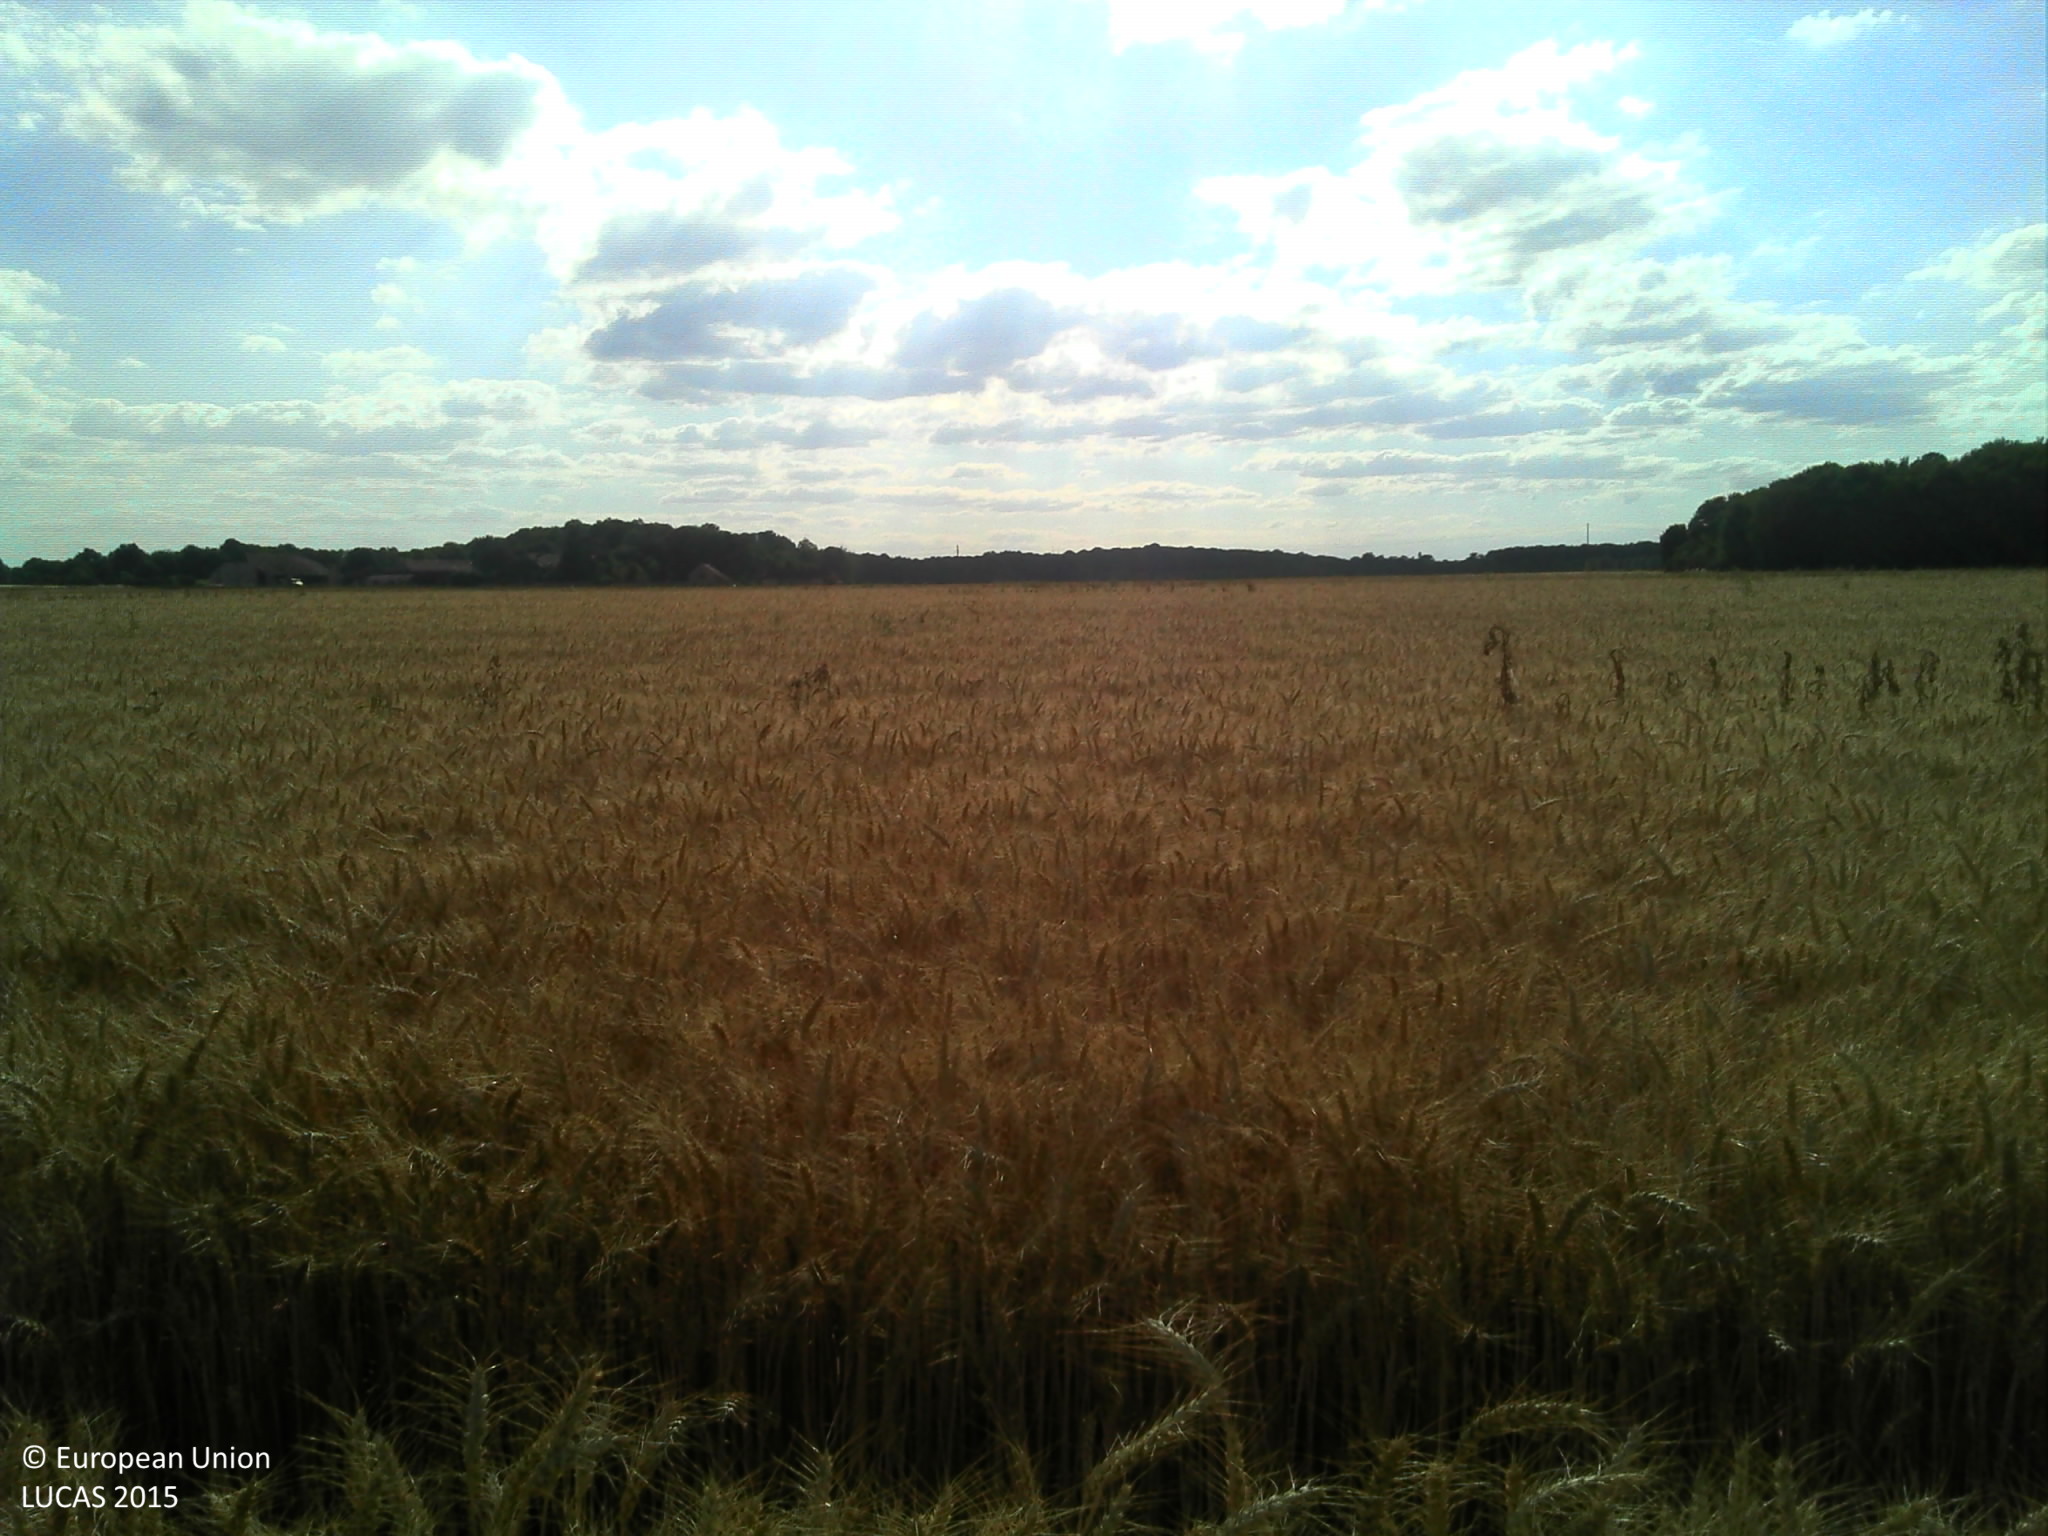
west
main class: Cropland
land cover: Common wheat
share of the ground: > 75 %
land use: Agriculture (excluding fallow land and kitchen gardens)
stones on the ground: < 10 %
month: July
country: FR
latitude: 48.5443
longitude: 2.7437
